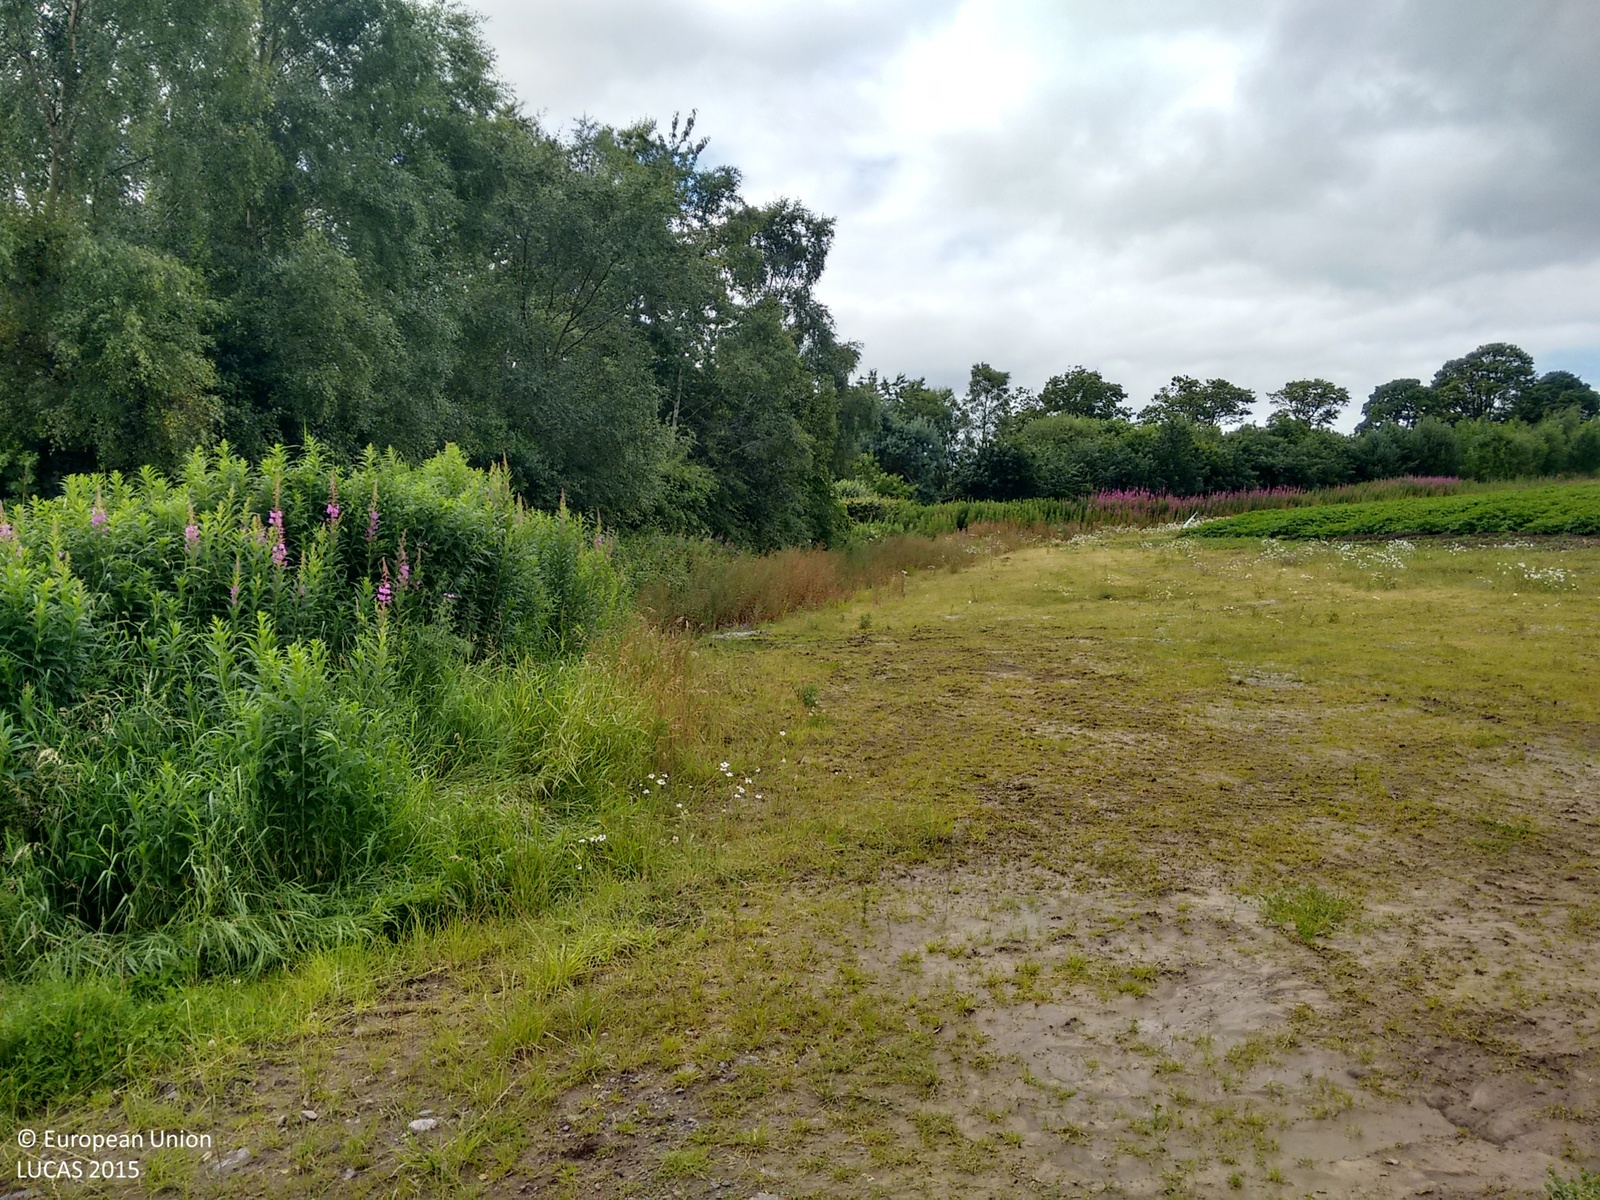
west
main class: Cropland
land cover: Potatoes
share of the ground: > 75 %
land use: Agriculture (excluding fallow land and kitchen gardens)
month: August
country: GB
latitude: 57.5827
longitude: -4.2513
